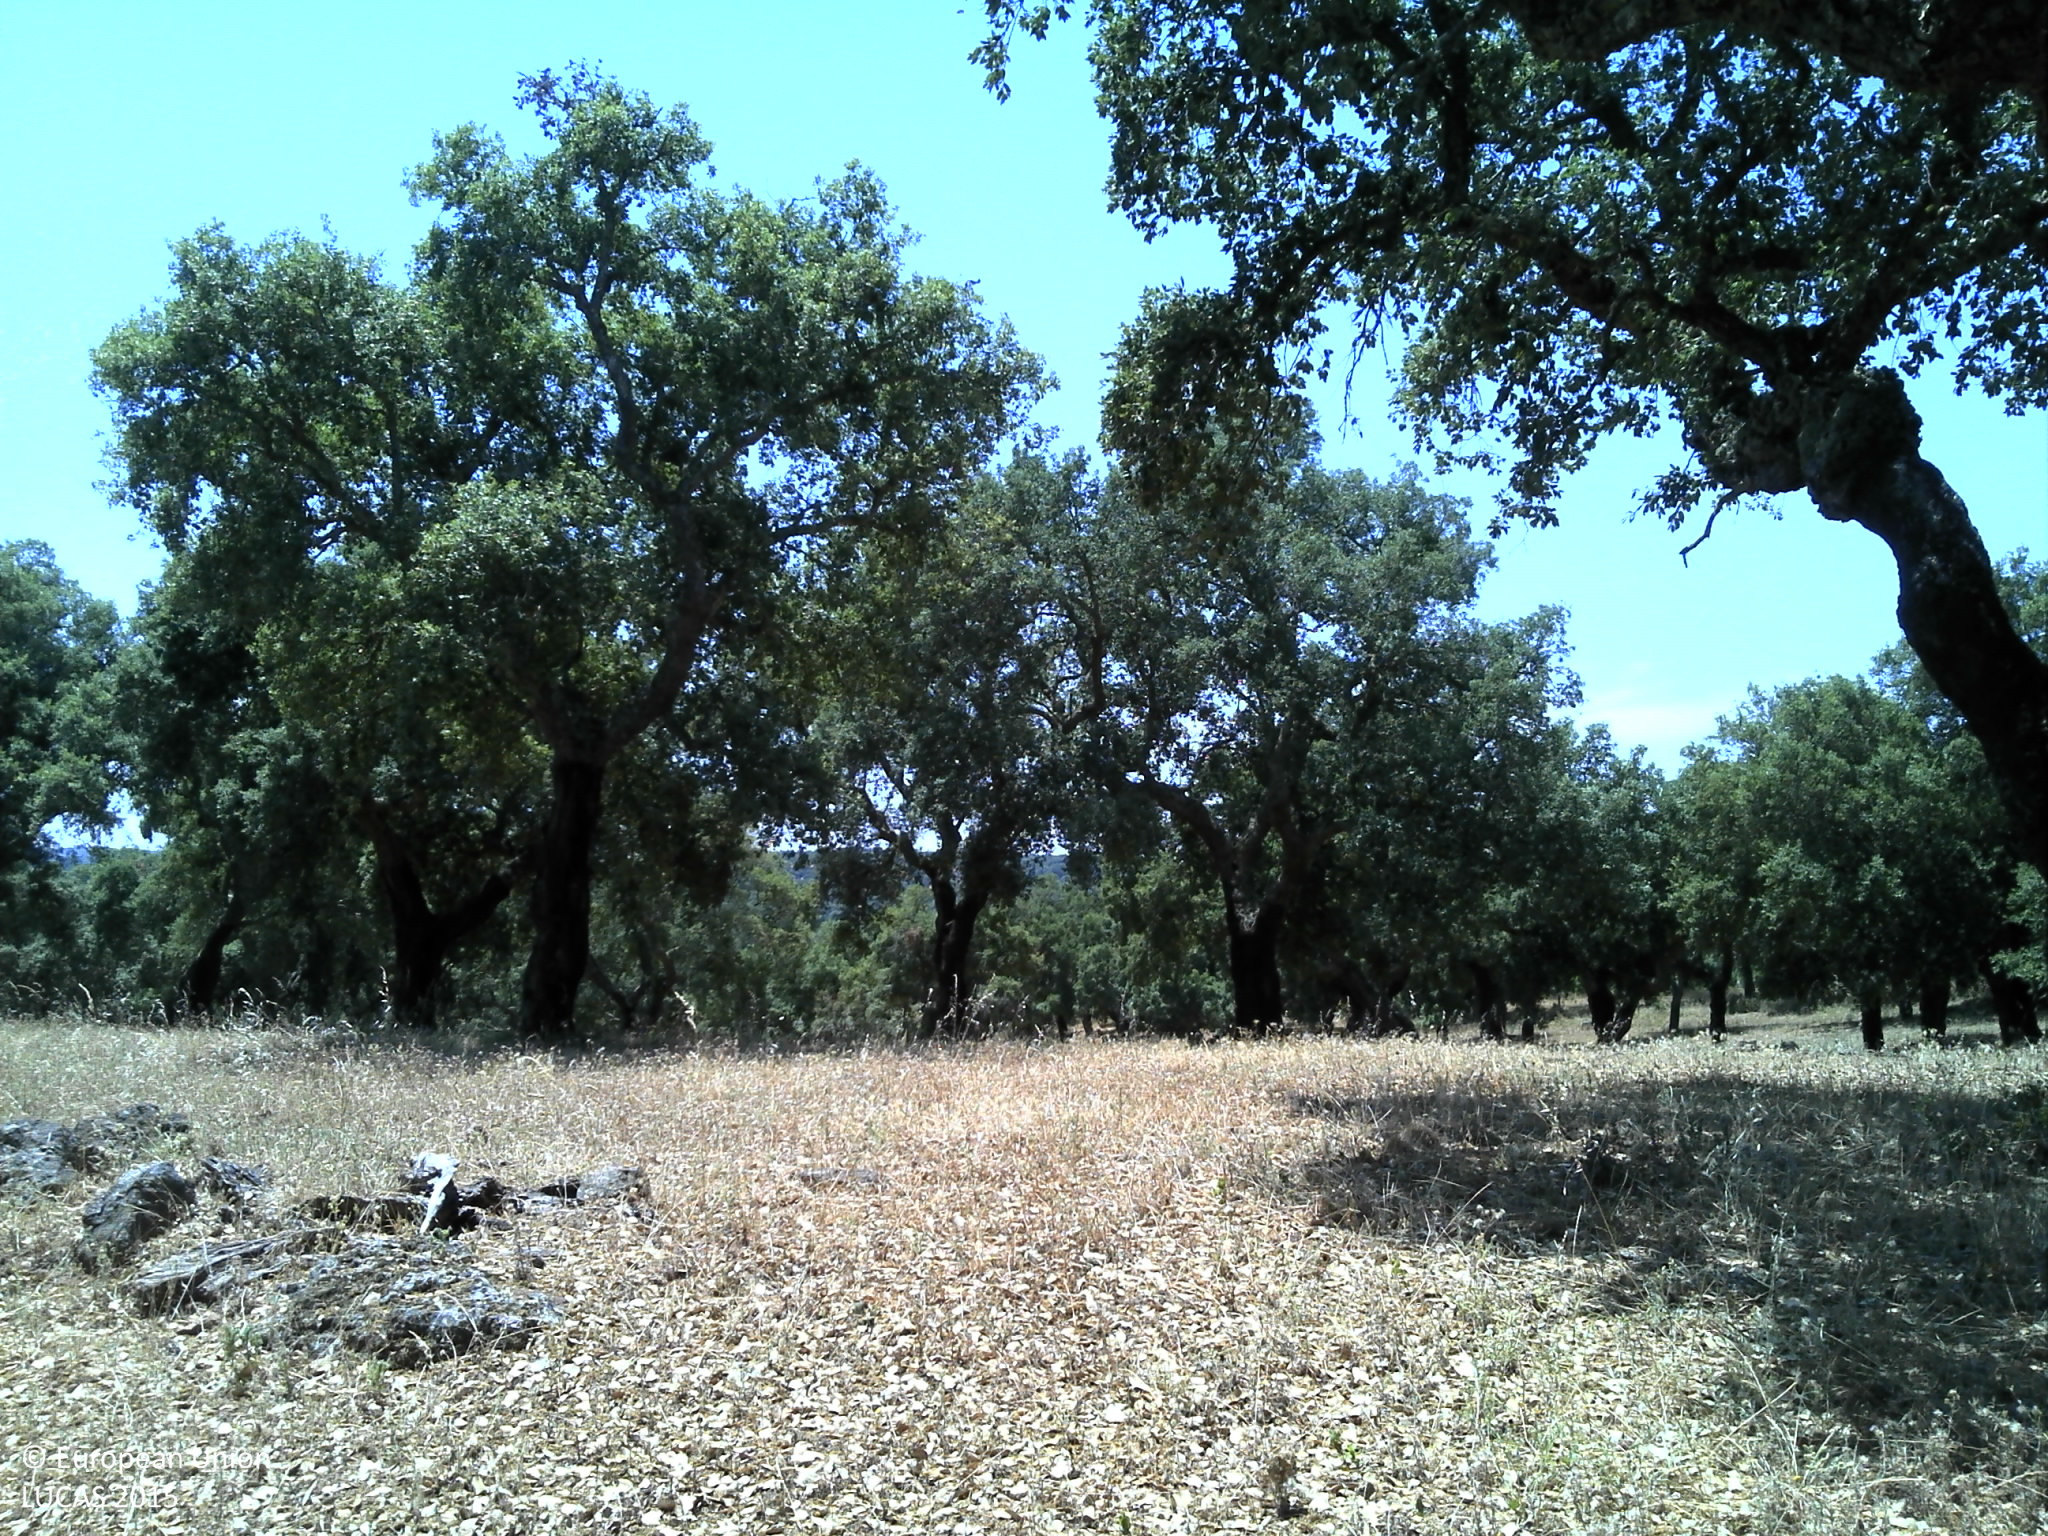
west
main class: Woodland
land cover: Broadleaved woodland
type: broadleaved evergreen forest
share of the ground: 50 - 75 %
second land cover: Grassland without tree/shrub cover
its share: 10 - 25 %
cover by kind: broadleaved forest trees 75 %, unconsolidated bare surface 15 %, herbaceous plants 10 %
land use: Forestry
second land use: Agriculture (excluding fallow land and kitchen gardens)
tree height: > 5 m
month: June
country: PT
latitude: 38.6124
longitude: -8.1571
